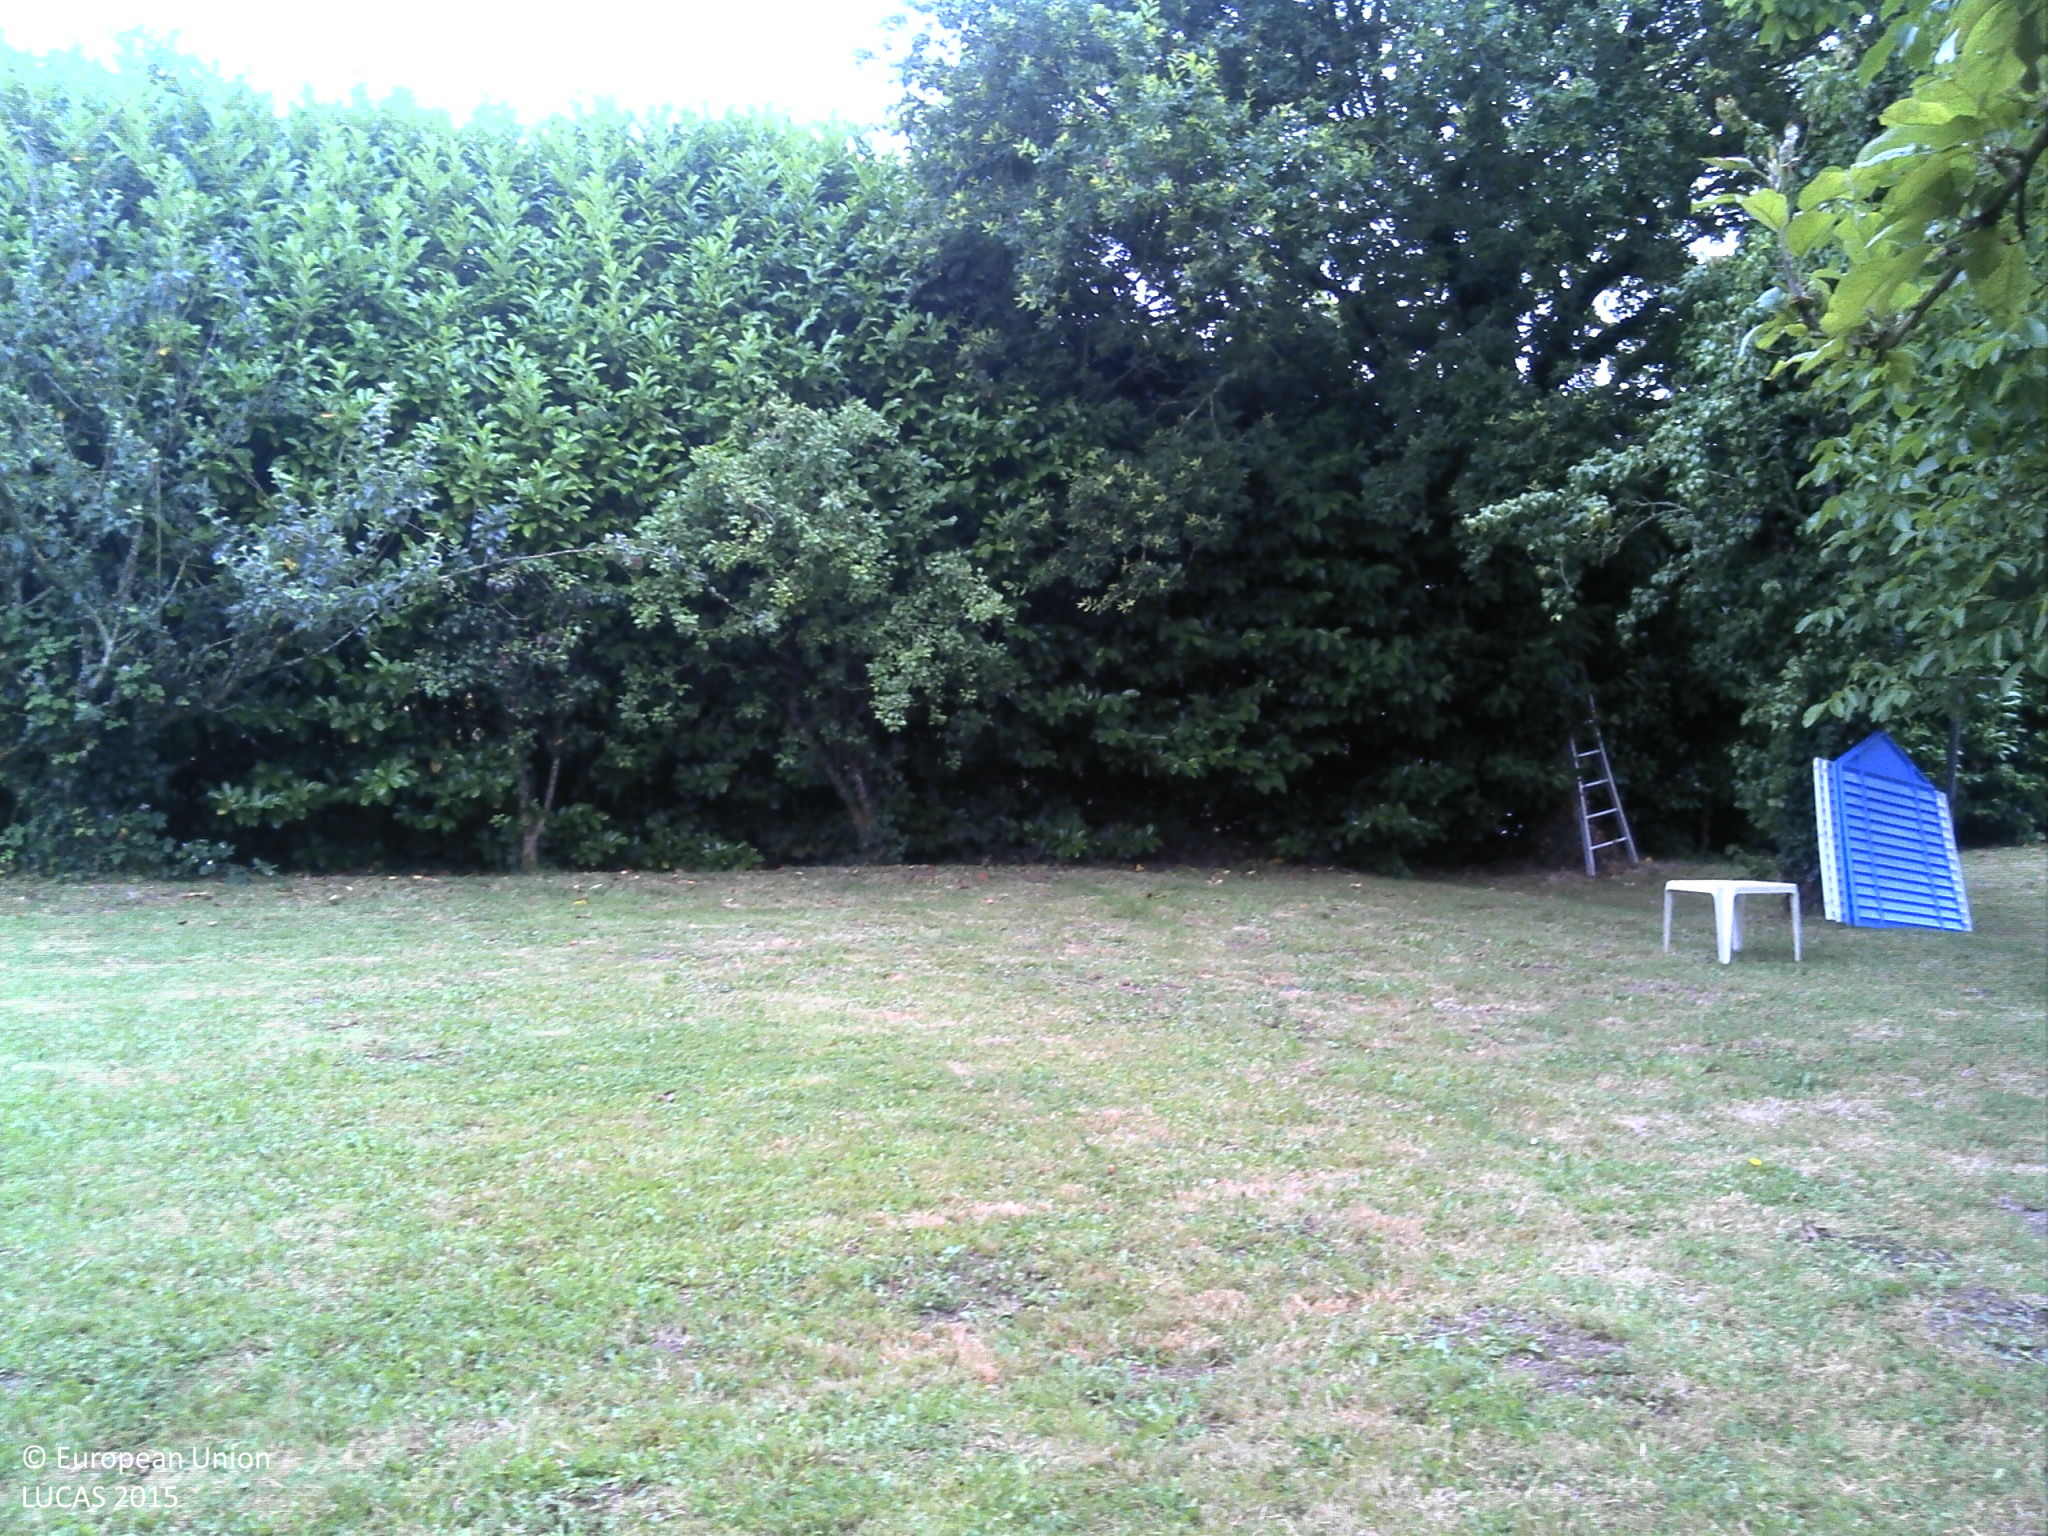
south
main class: Grassland
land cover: Grassland with sparse tree/shrub cover
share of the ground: > 75 %
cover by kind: herbaceous plants 85 %, shrubs 10 %, coniferous forest trees 5 %
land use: Residential
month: July
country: FR
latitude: 48.2176
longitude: -4.1553
